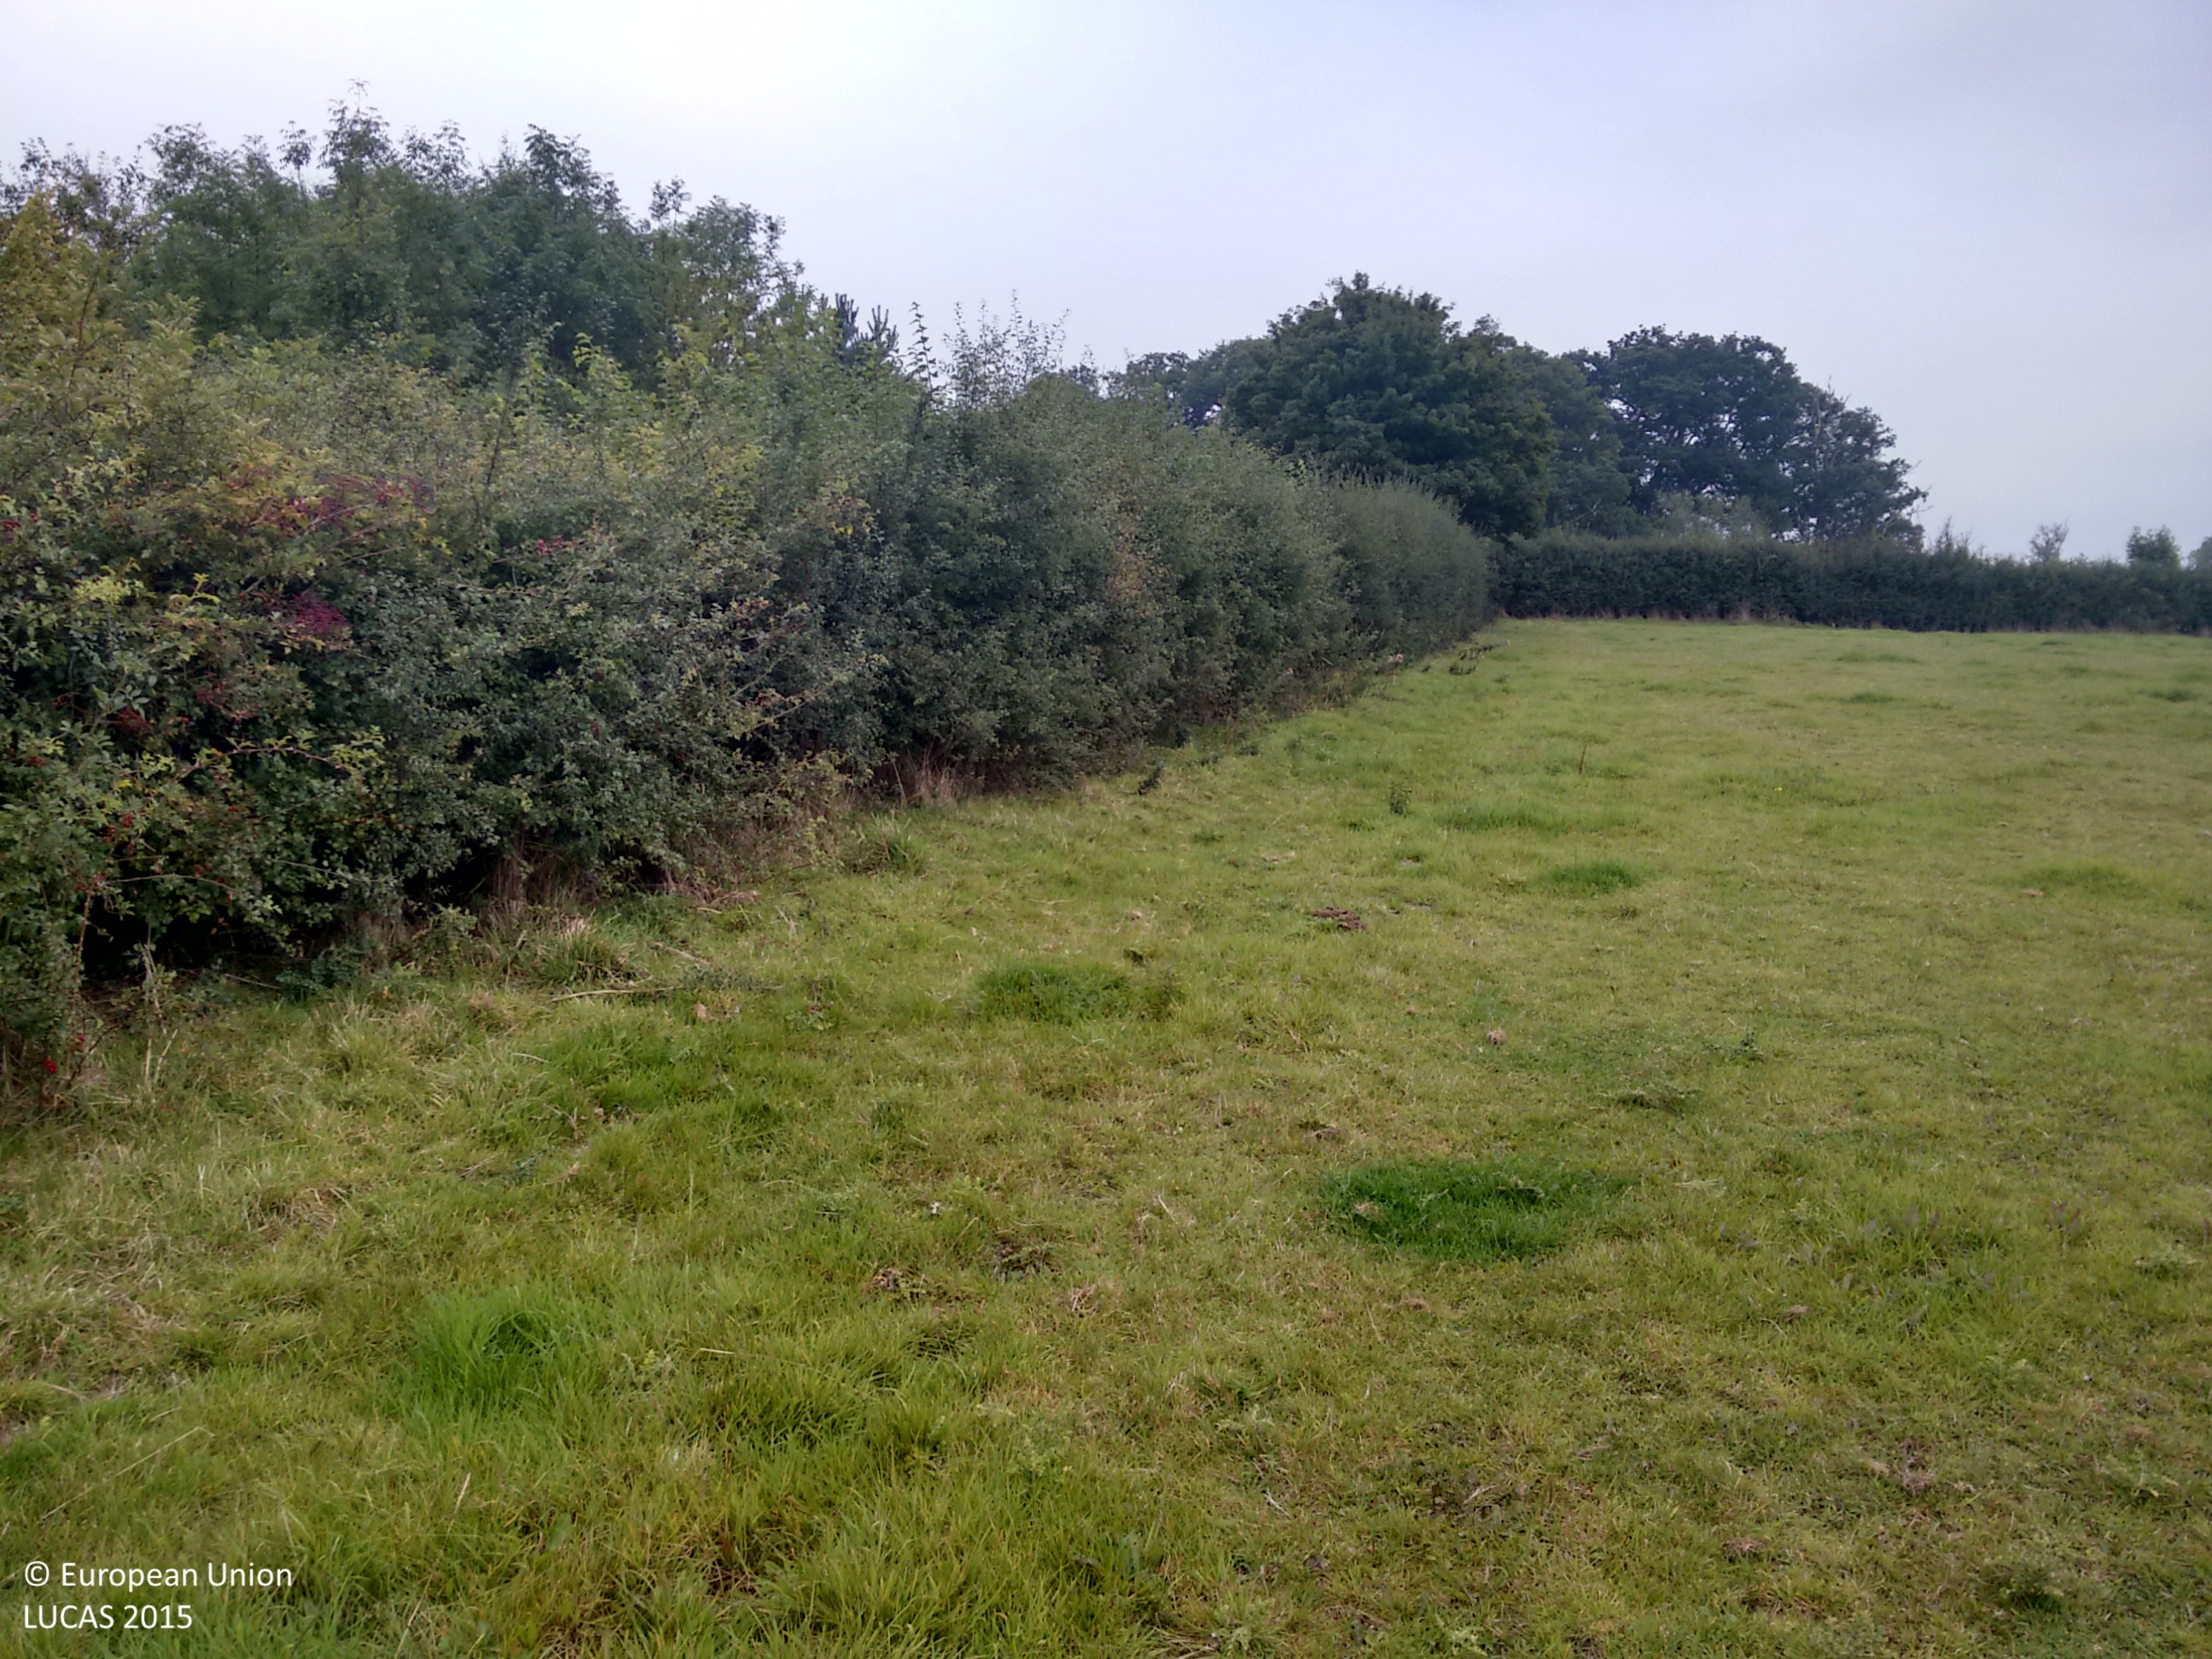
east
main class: Woodland
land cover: Broadleaved woodland
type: mesophytic deciduous forest
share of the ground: > 75 %
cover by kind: broadleaved forest trees 100 %
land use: Forestry
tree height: > 5 m
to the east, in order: Broadleaved woodland; Grassland with sparse tree/shrub cover; Grass margins; Broadleaved woodland; Fences; Grassland without tree/shrub cover; Abandoned hedges; Grassland without tree/shrub cover
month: September
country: GB
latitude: 52.7524
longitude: -2.8283
